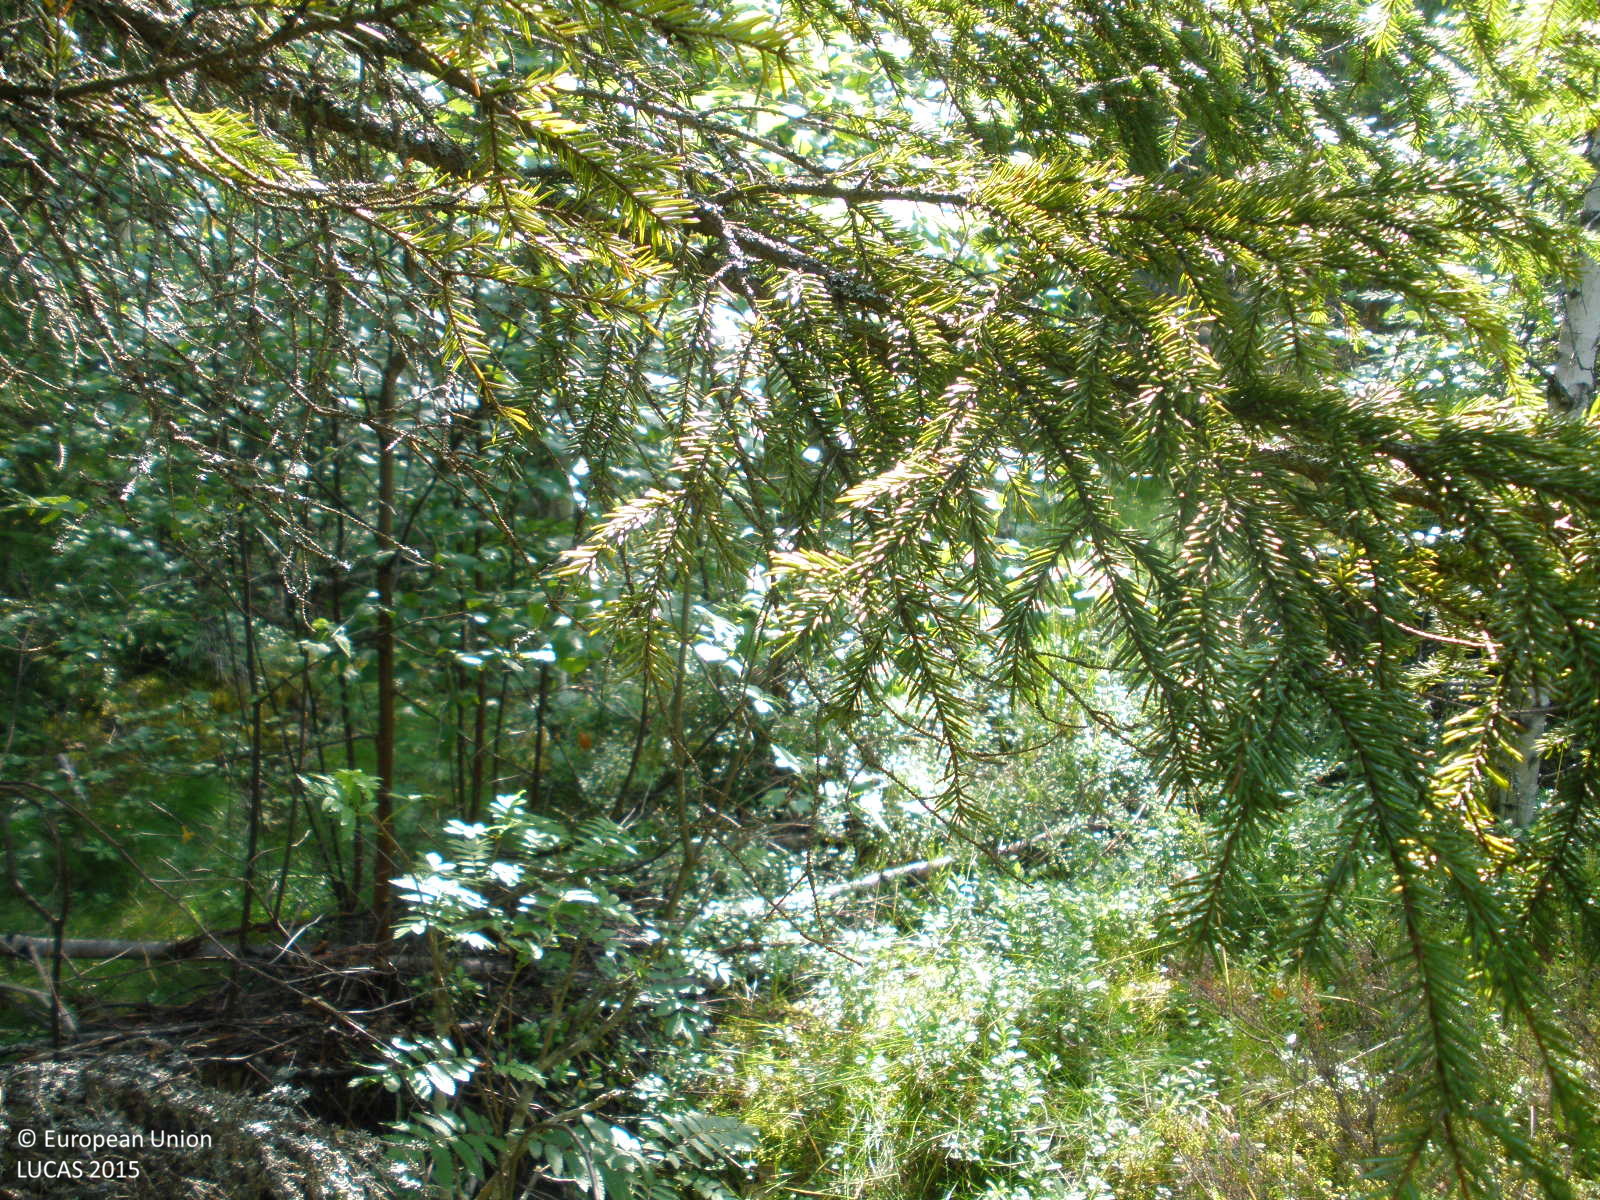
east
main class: Woodland
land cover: Spruce dominated mixed woodland
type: boreal forest
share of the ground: 50 - 75 %
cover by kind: coniferous forest trees 40 %, broadleaved forest trees 25 %, herbaceous plants 20 %, shrubs 10 %, lichens and mosses 5 %
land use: Forestry
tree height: > 5 m
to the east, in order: Spruce dominated mixed woodland; Pine dominated coniferous woodland; Pine dominated mixed woodland; Spruce dominated mixed woodland; Ditches and canals; Shruby margins; Tracks; Shruby margins; Ditches and canals; Spruce dominated mixed woodland
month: July
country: FI
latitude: 61.5766
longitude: 24.6592
